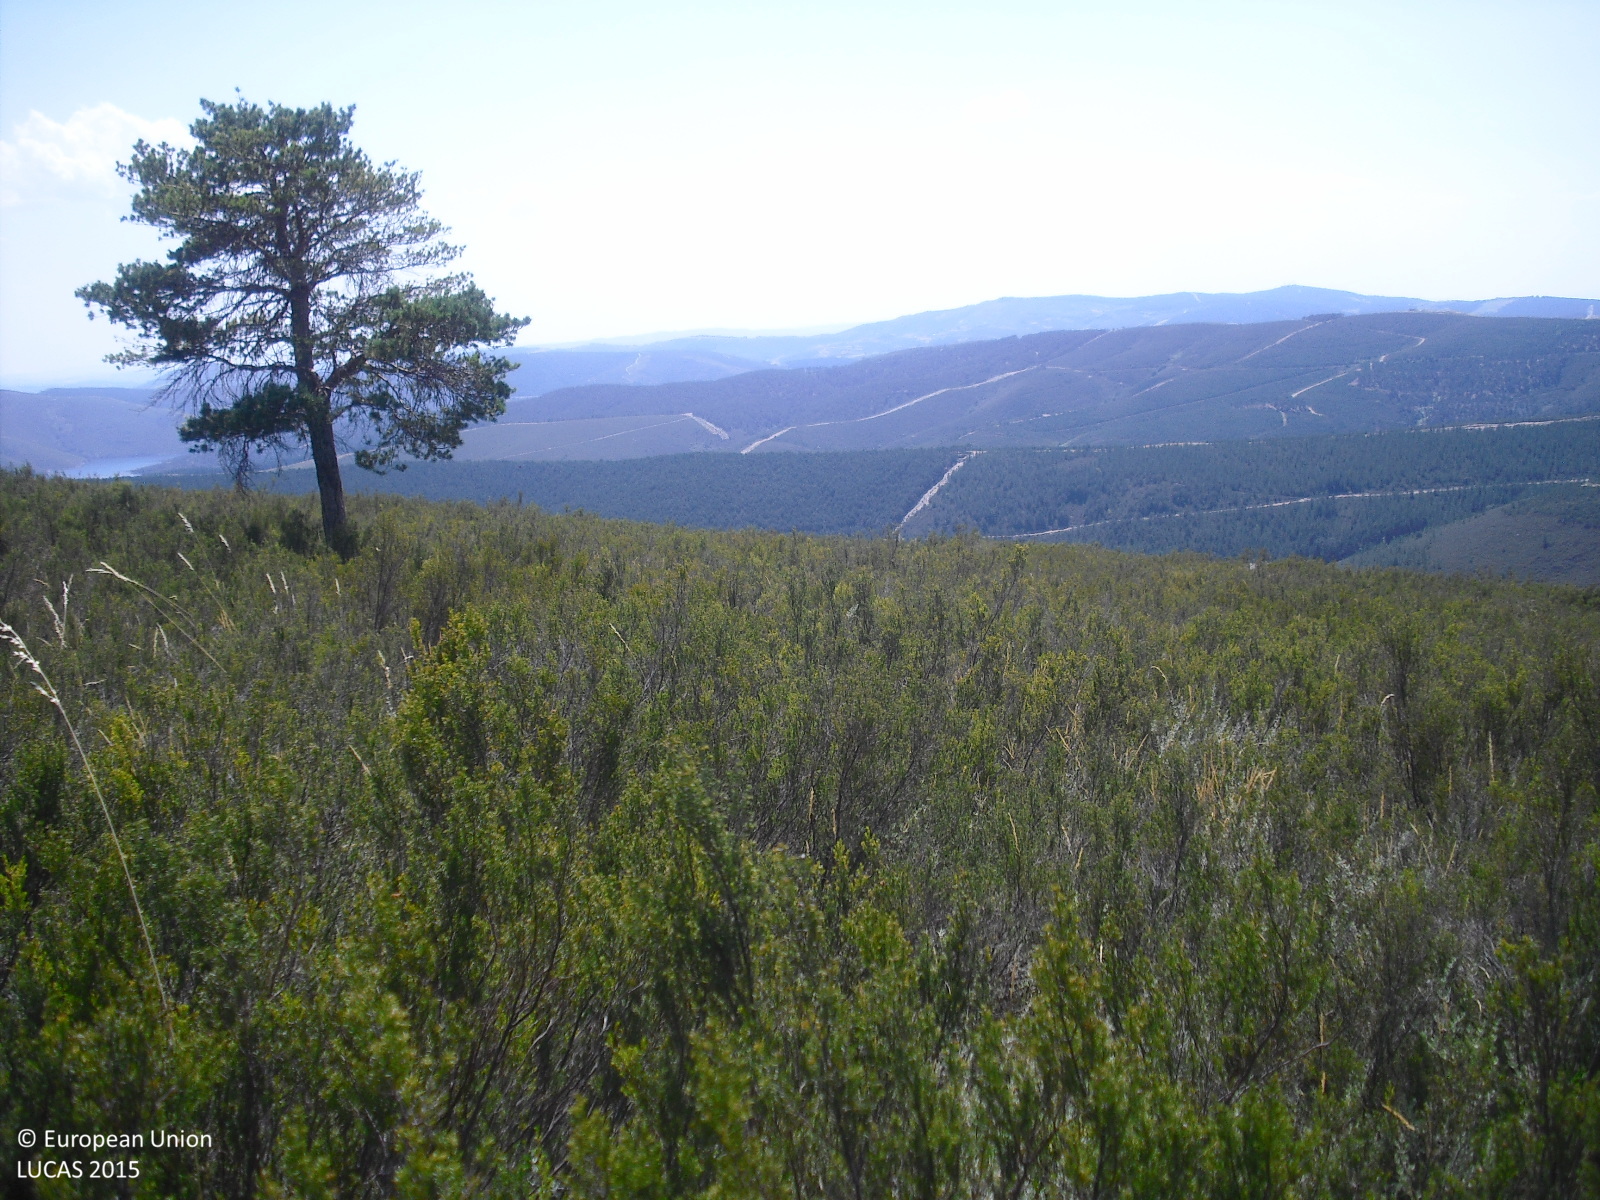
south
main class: Shrubland
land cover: Shrubland with sparse tree cover
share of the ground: > 75 %
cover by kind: shrubs 95 %, coniferous forest trees 5 %
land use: Semi-natural and natural areas not in use
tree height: < 5 m
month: August
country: ES
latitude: 42.1250
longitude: -7.3211
